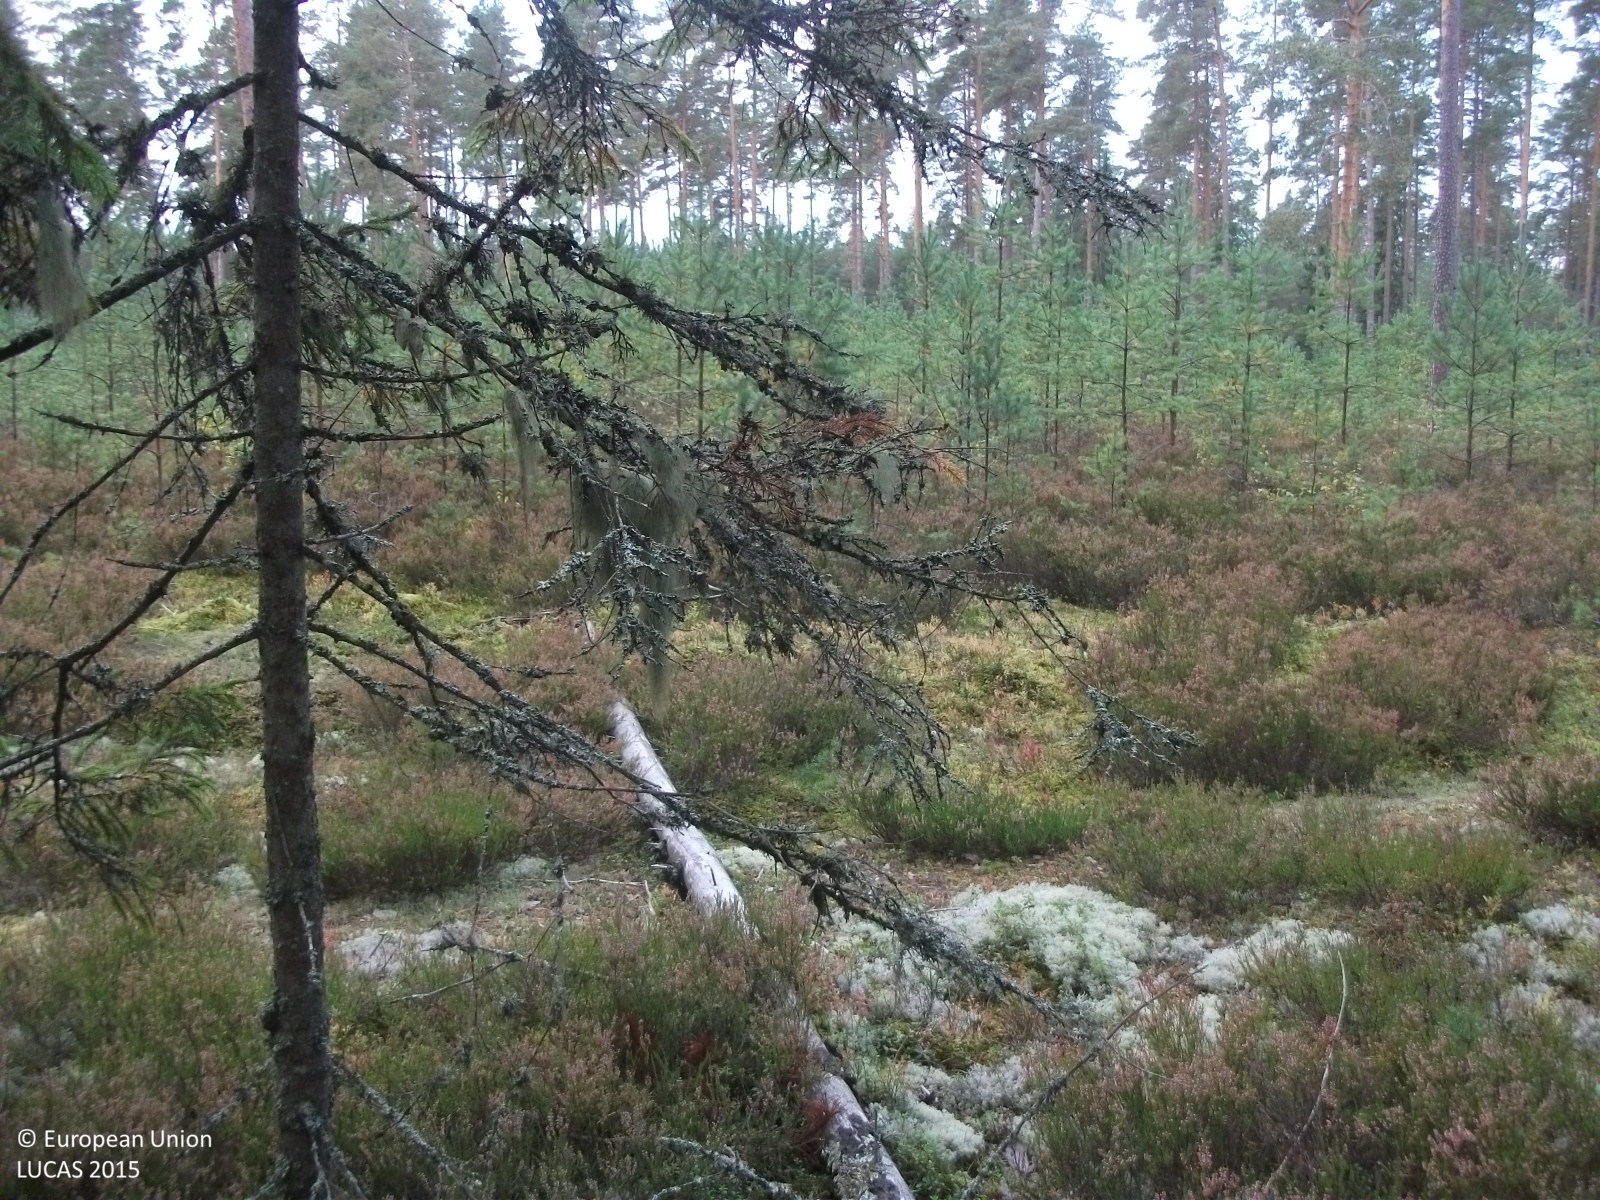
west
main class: Woodland
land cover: Pine dominated coniferous woodland
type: hemiboreal forest and nemoral coniferous forest and mixed broadleaved-coniferous forest
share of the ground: > 75 %
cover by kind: coniferous forest trees 80 %, lichens and mosses 15 %, herbaceous plants 5 %
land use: Forestry
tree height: > 5 m
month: September
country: LV
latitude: 57.6876
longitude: 24.4640
